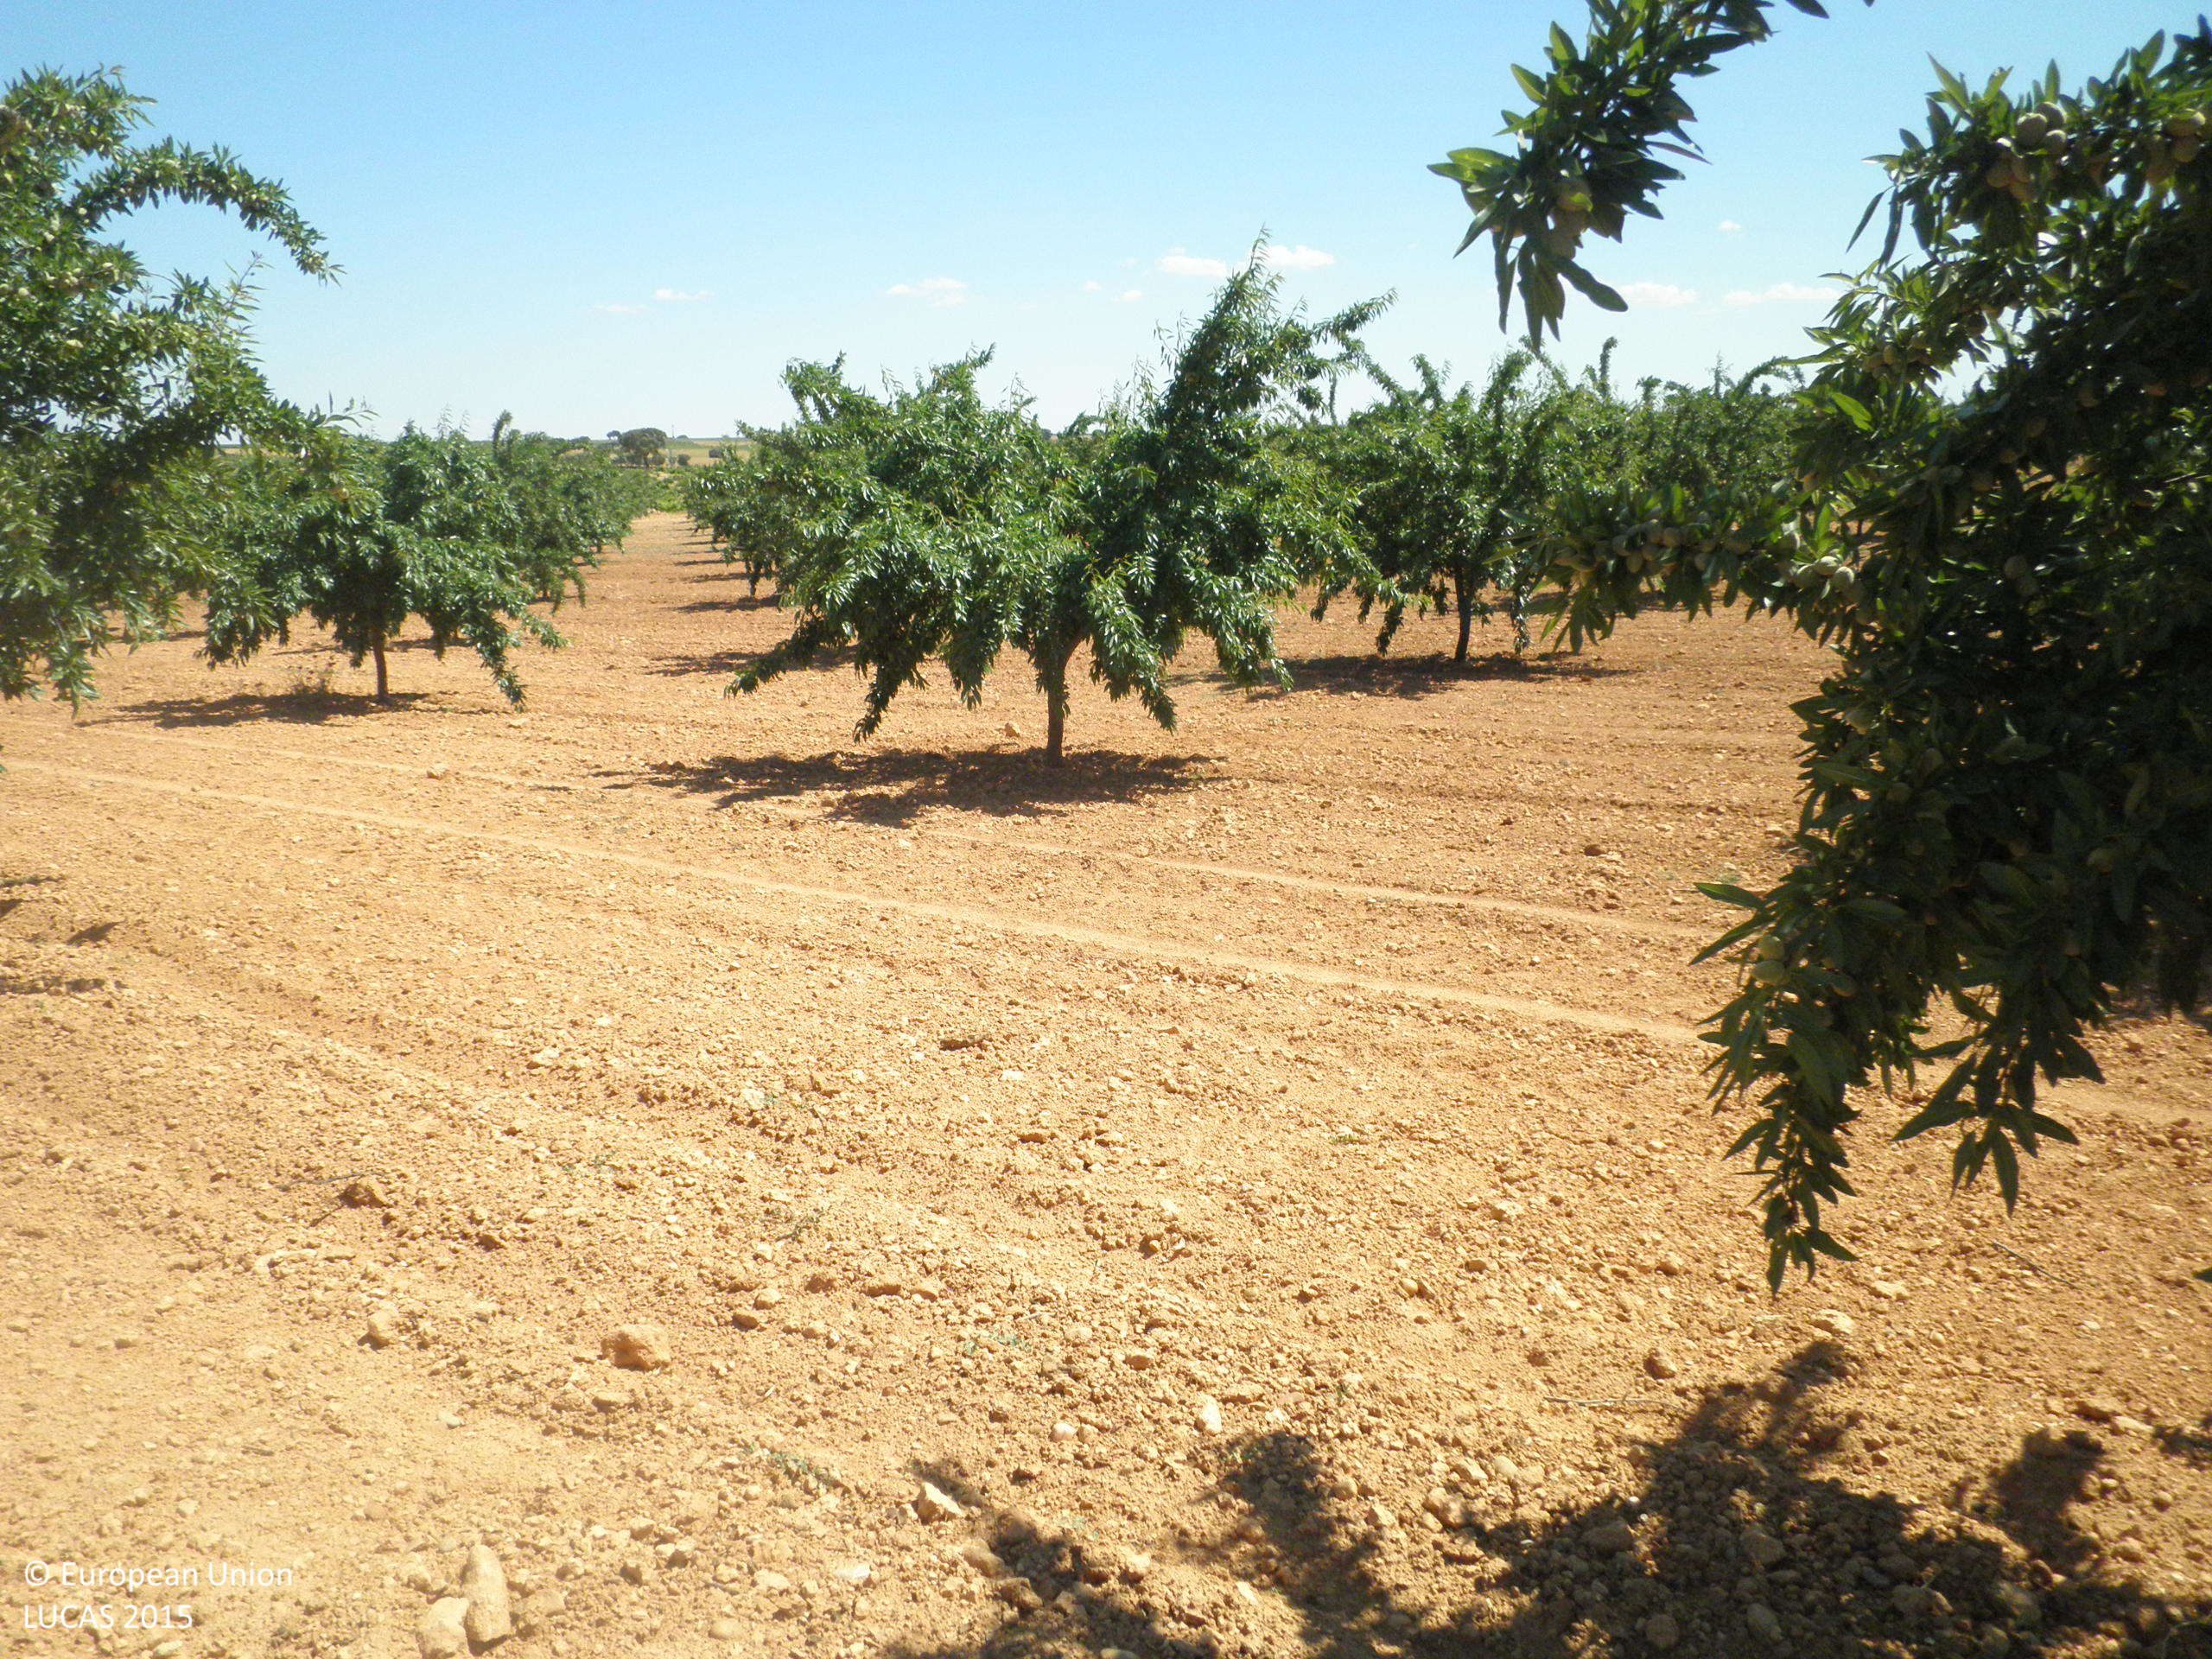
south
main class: Cropland
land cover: Nuts trees
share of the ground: 10 - 25 %
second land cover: Other bare soil
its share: > 75 %
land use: Agriculture (excluding fallow land and kitchen gardens)
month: June
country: ES
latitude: 39.3866
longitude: -1.8124
